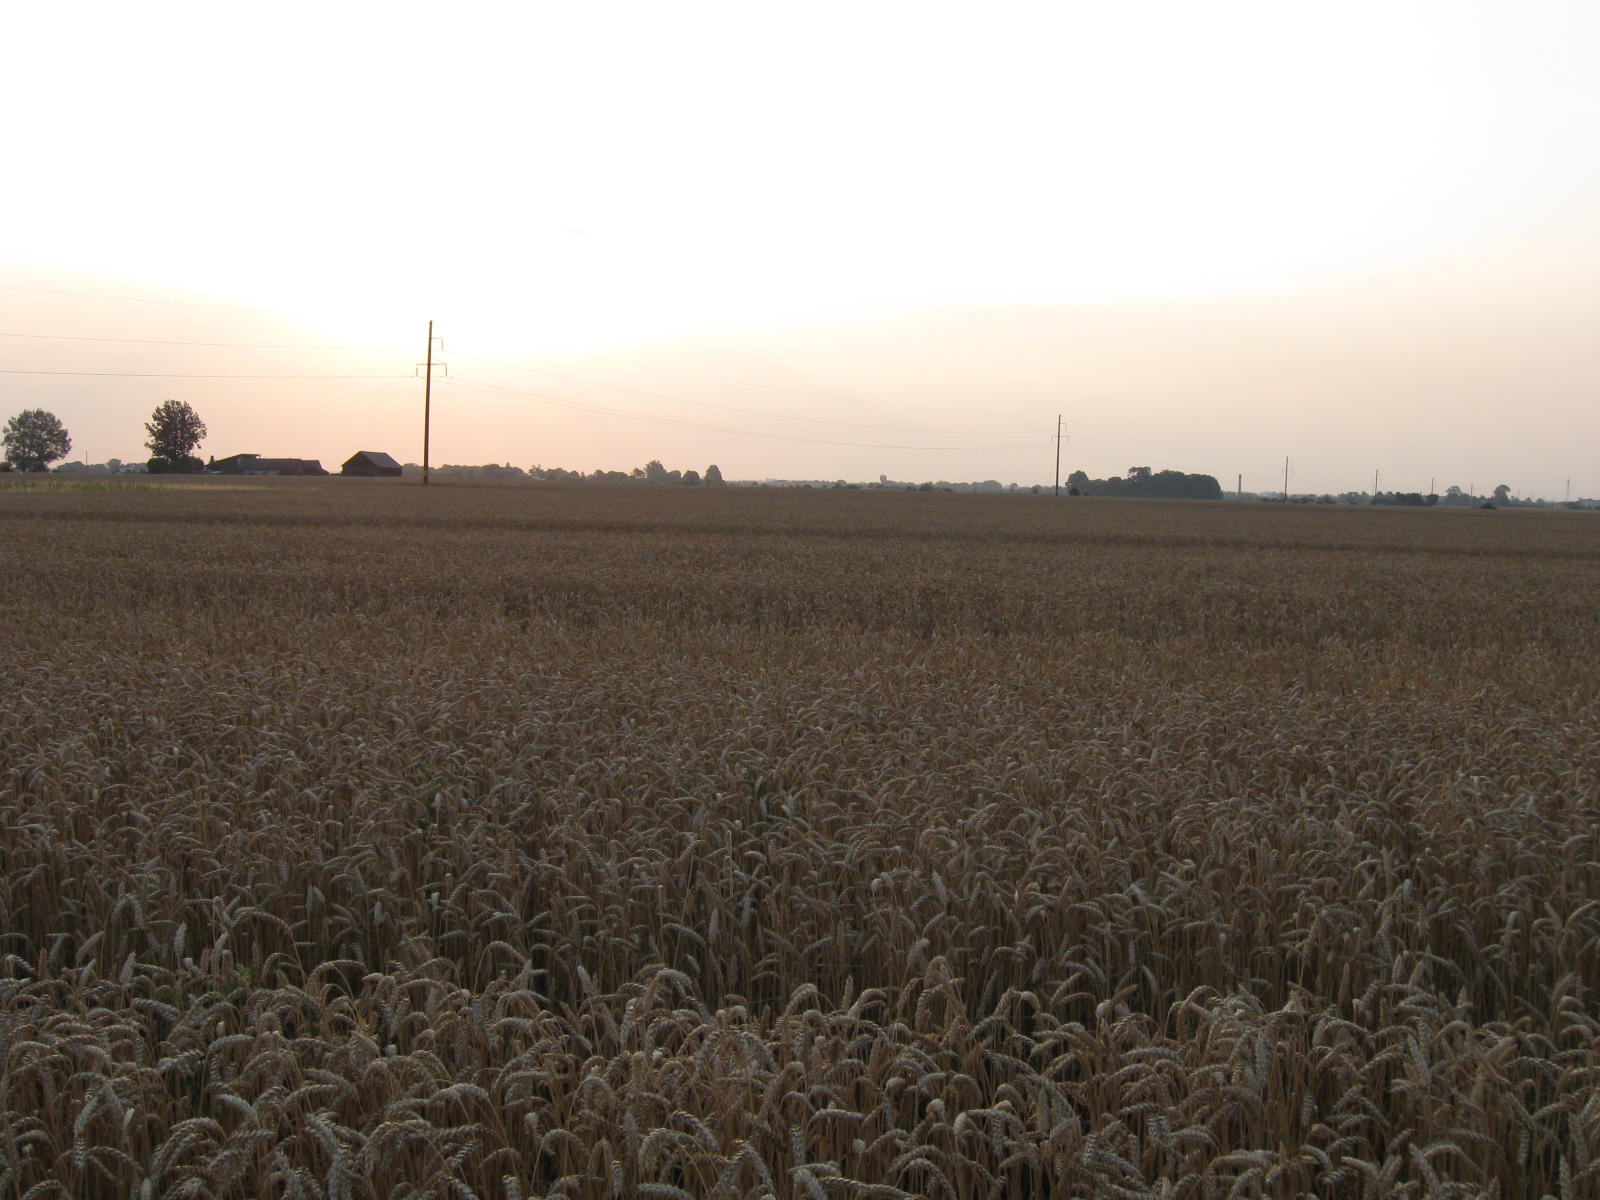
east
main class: Cropland
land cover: Common wheat
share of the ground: > 75 %
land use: Agriculture (excluding fallow land and kitchen gardens)
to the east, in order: Common wheat
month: August
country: LT
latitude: 54.5431
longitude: 23.2942
